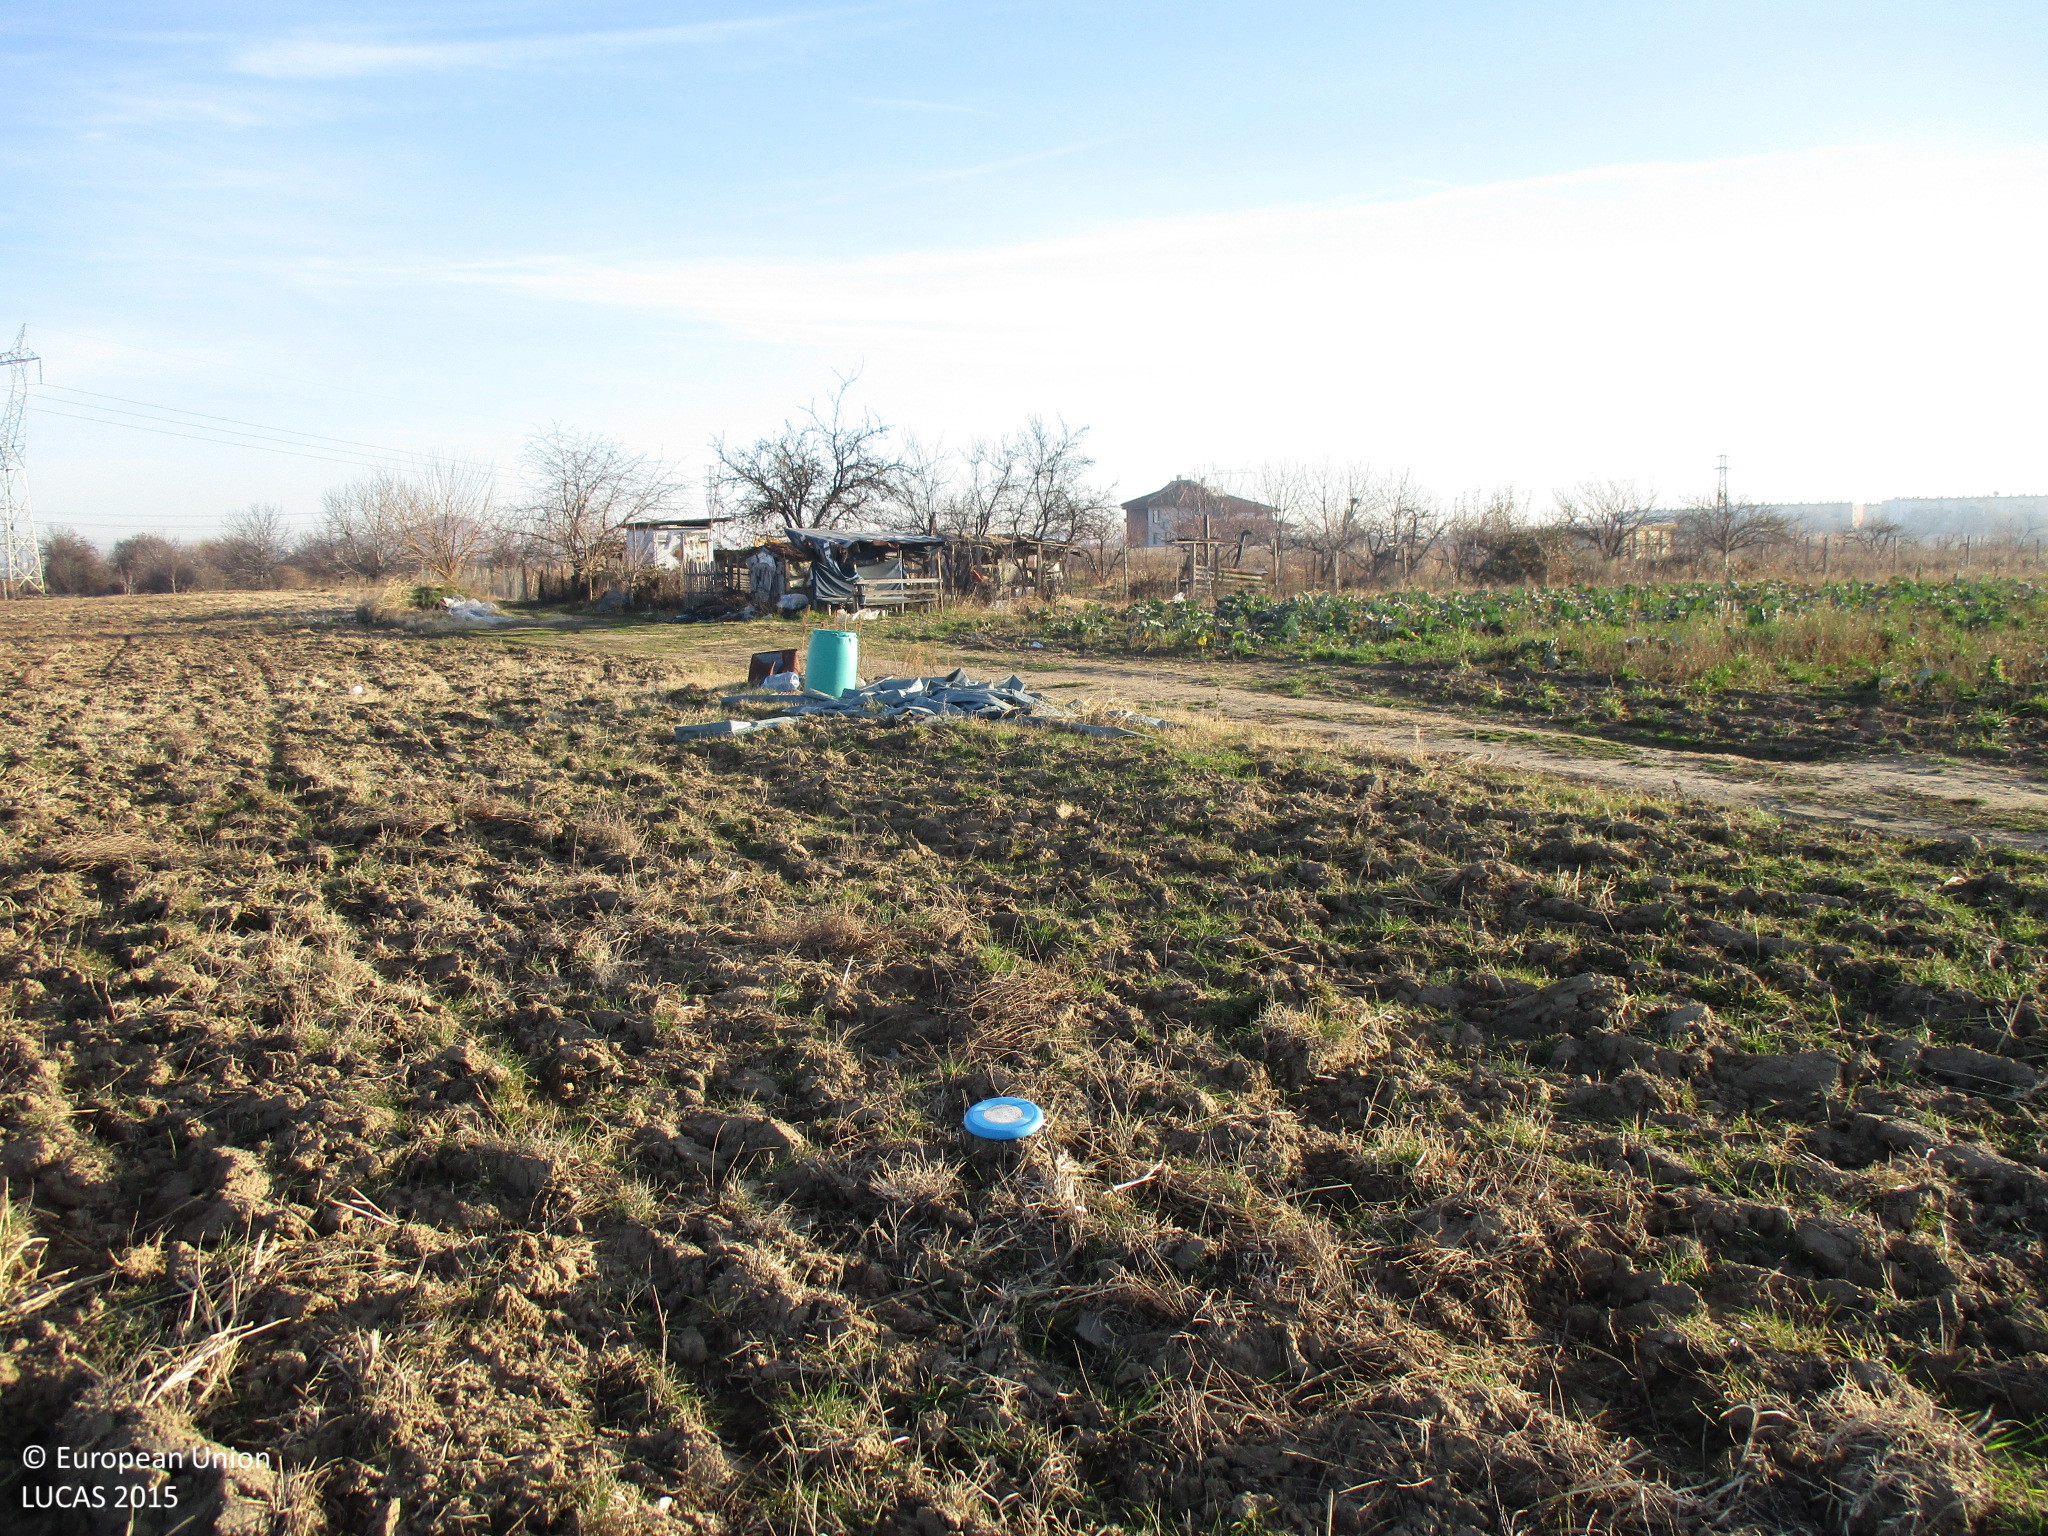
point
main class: Cropland
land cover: Common wheat
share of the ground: < 10 %
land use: Agriculture (excluding fallow land and kitchen gardens)
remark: Harvested field
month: December
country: BG
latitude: 42.1070
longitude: 24.6947
